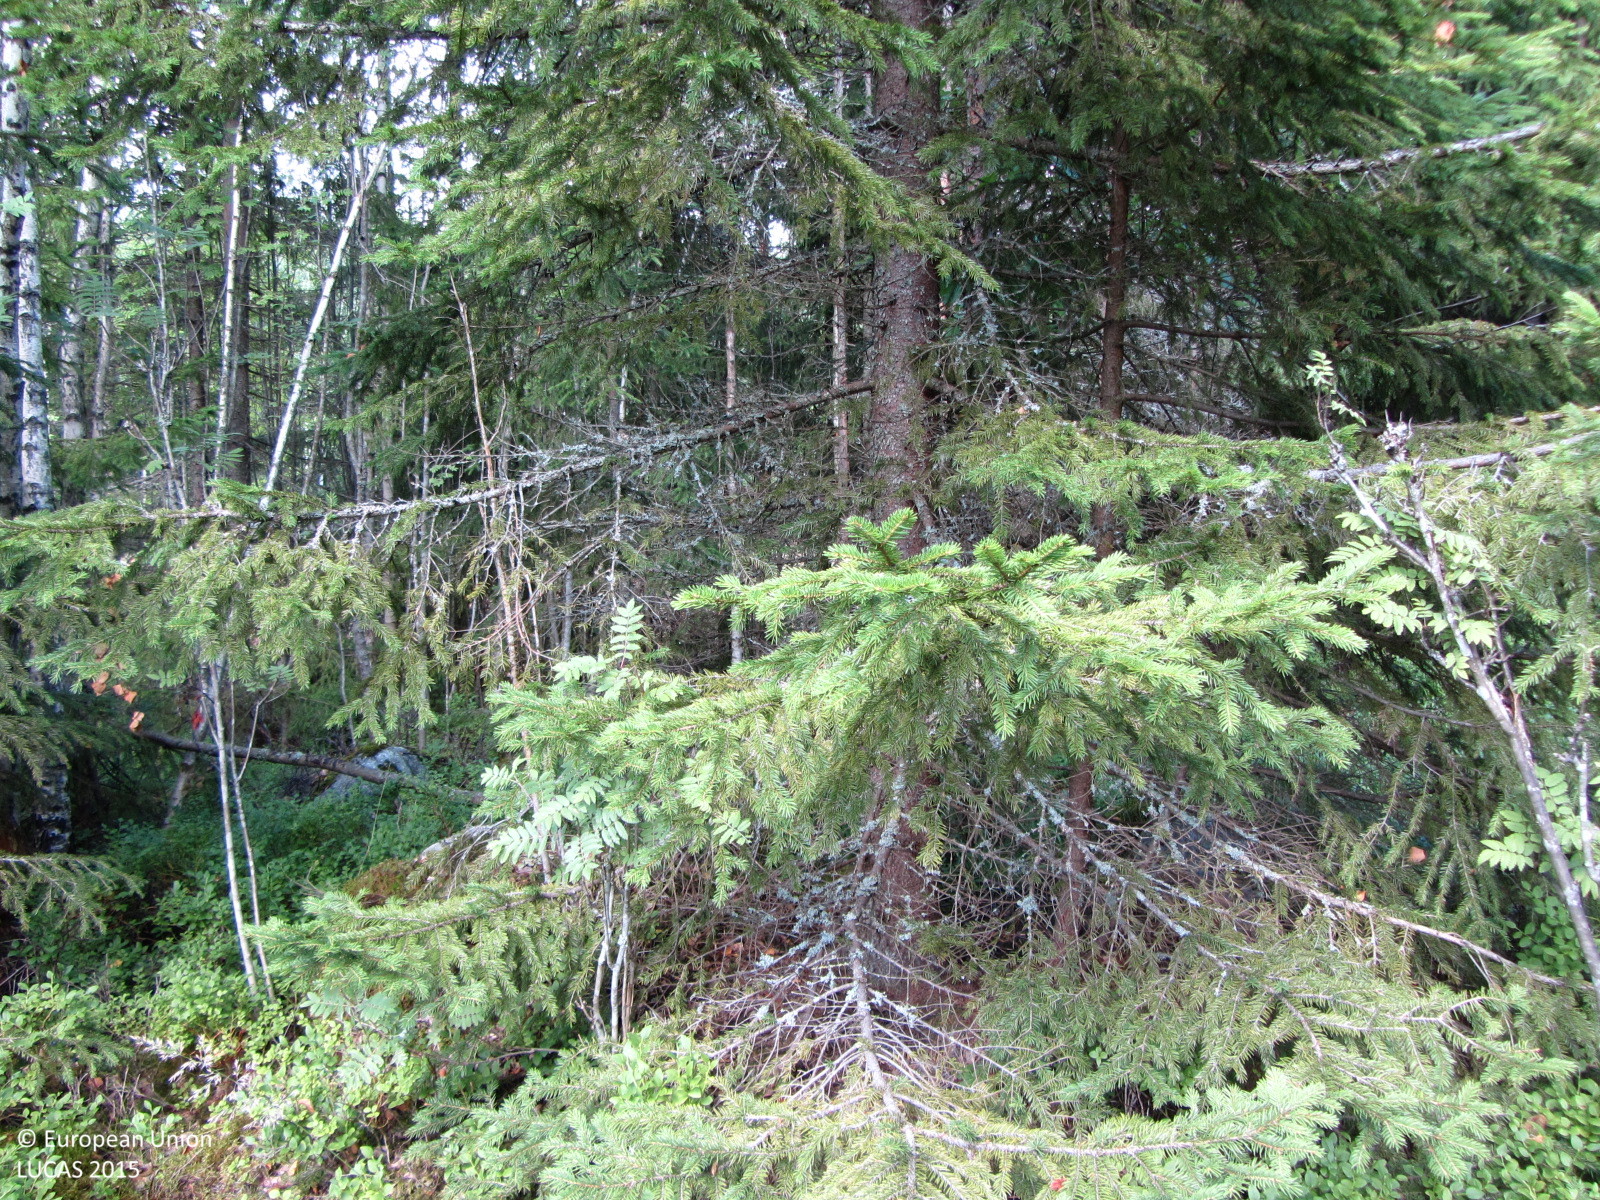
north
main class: Woodland
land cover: Spruce dominated mixed woodland
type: hemiboreal forest and nemoral coniferous forest and mixed broadleaved-coniferous forest
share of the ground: 50 - 75 %
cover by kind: coniferous forest trees 35 %, shrubs 25 %, broadleaved forest trees 20 %, herbaceous plants 20 %
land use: Forestry
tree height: > 5 m
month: July
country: FI
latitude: 60.1980
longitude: 24.4845
